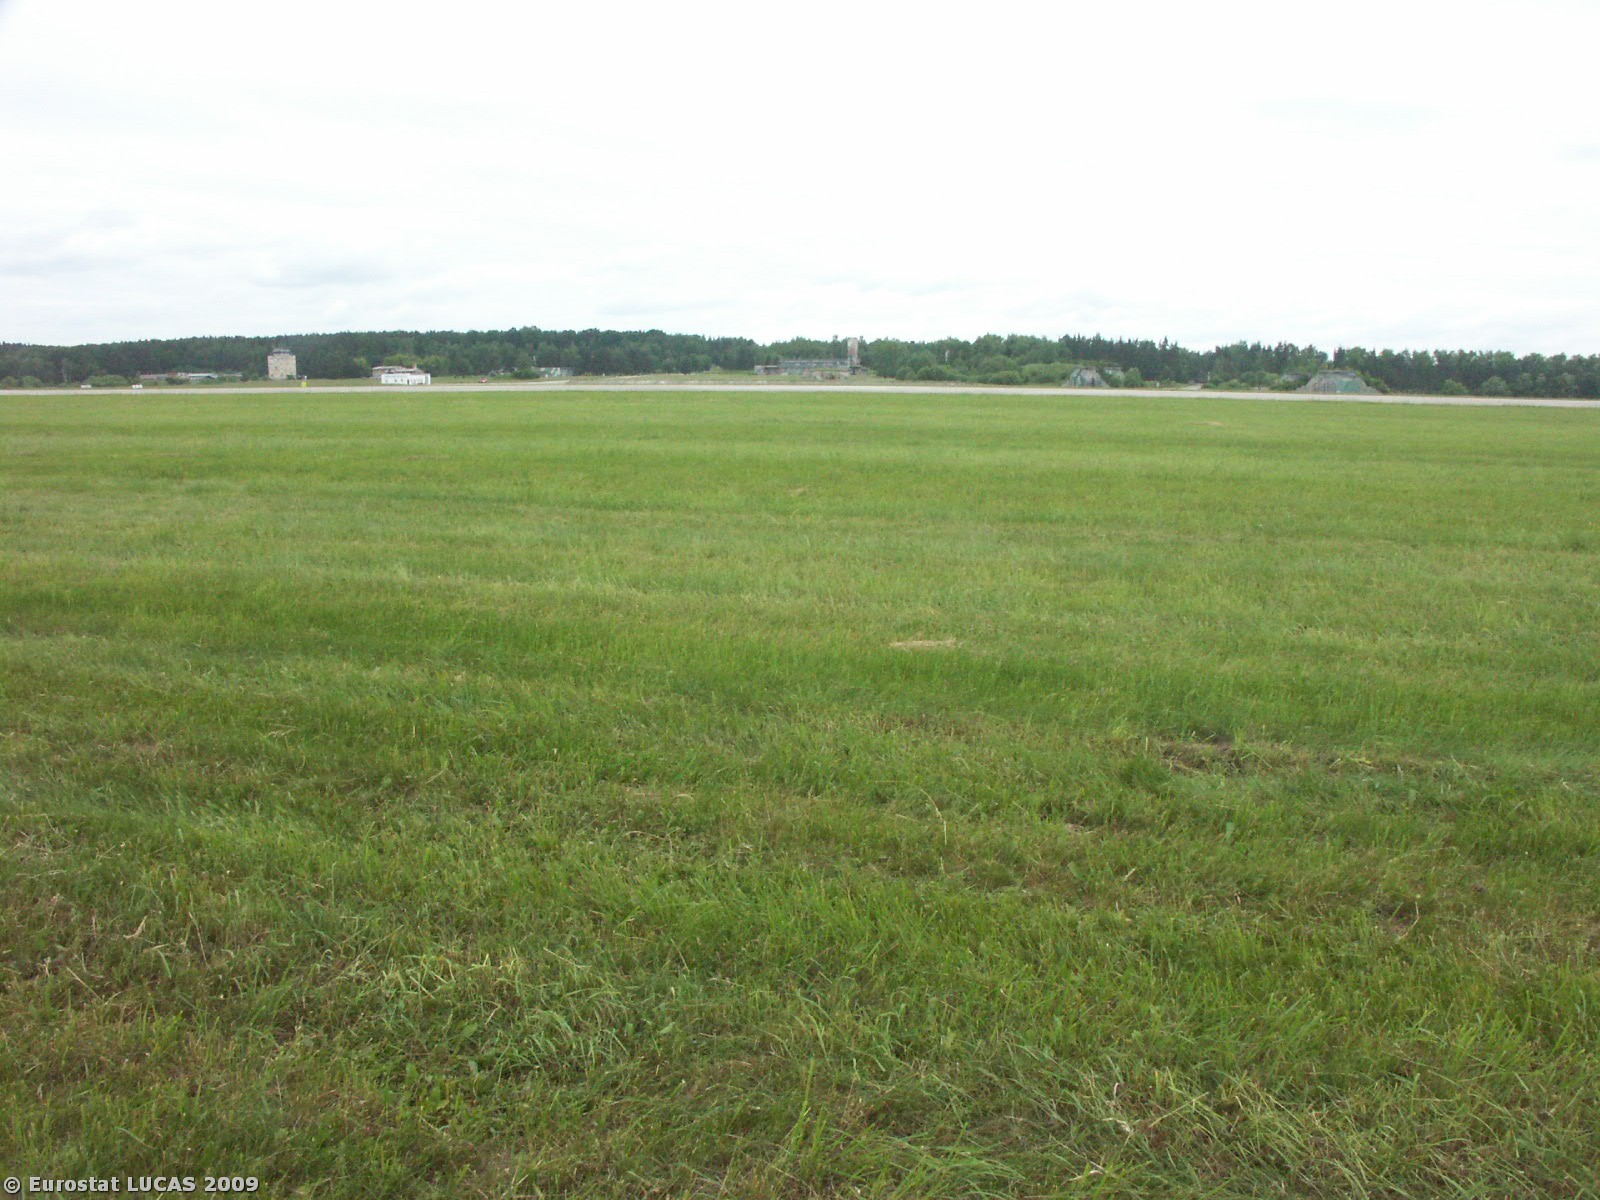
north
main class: Grassland
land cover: Grassland without tree/shrub cover
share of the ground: > 75 %
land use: Air transport
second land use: Community services
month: May
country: CZ
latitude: 48.9451
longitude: 14.4385
